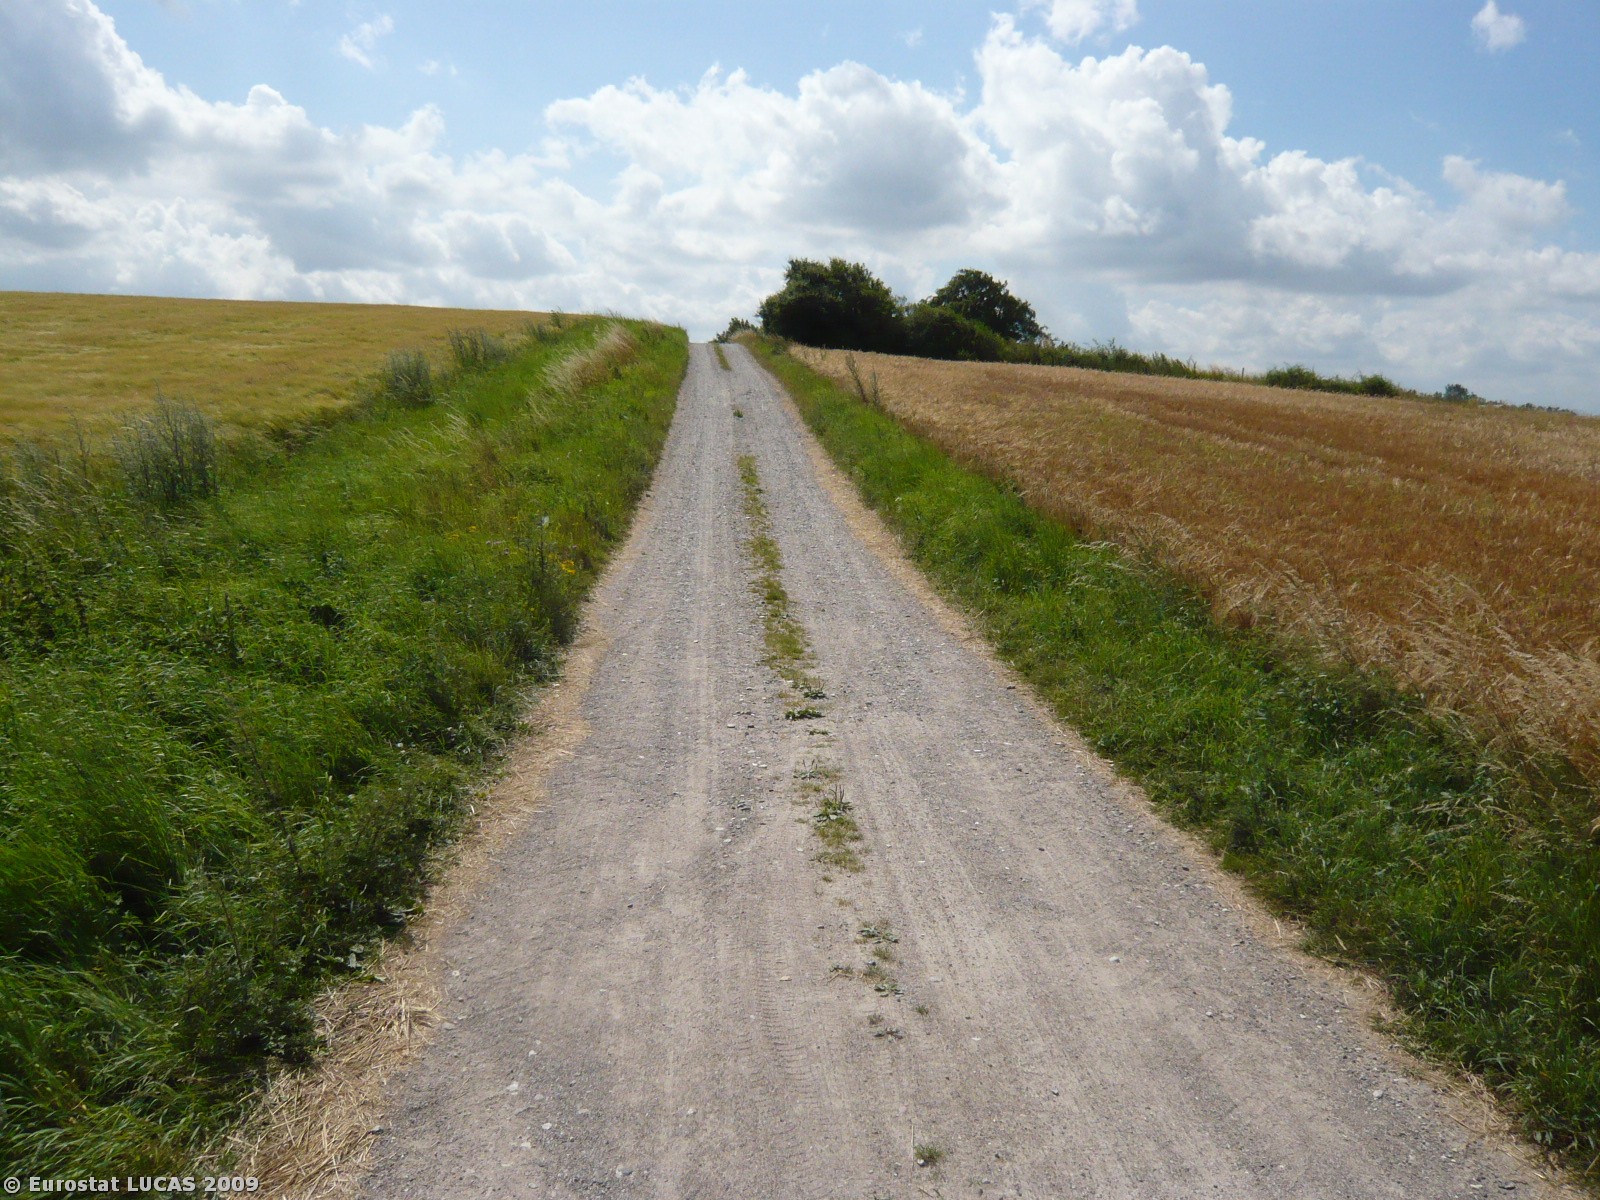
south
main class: Cropland
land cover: Barley
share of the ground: > 75 %
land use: Agriculture (excluding fallow land and kitchen gardens)
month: July
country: DK
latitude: 55.6902
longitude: 11.7641
